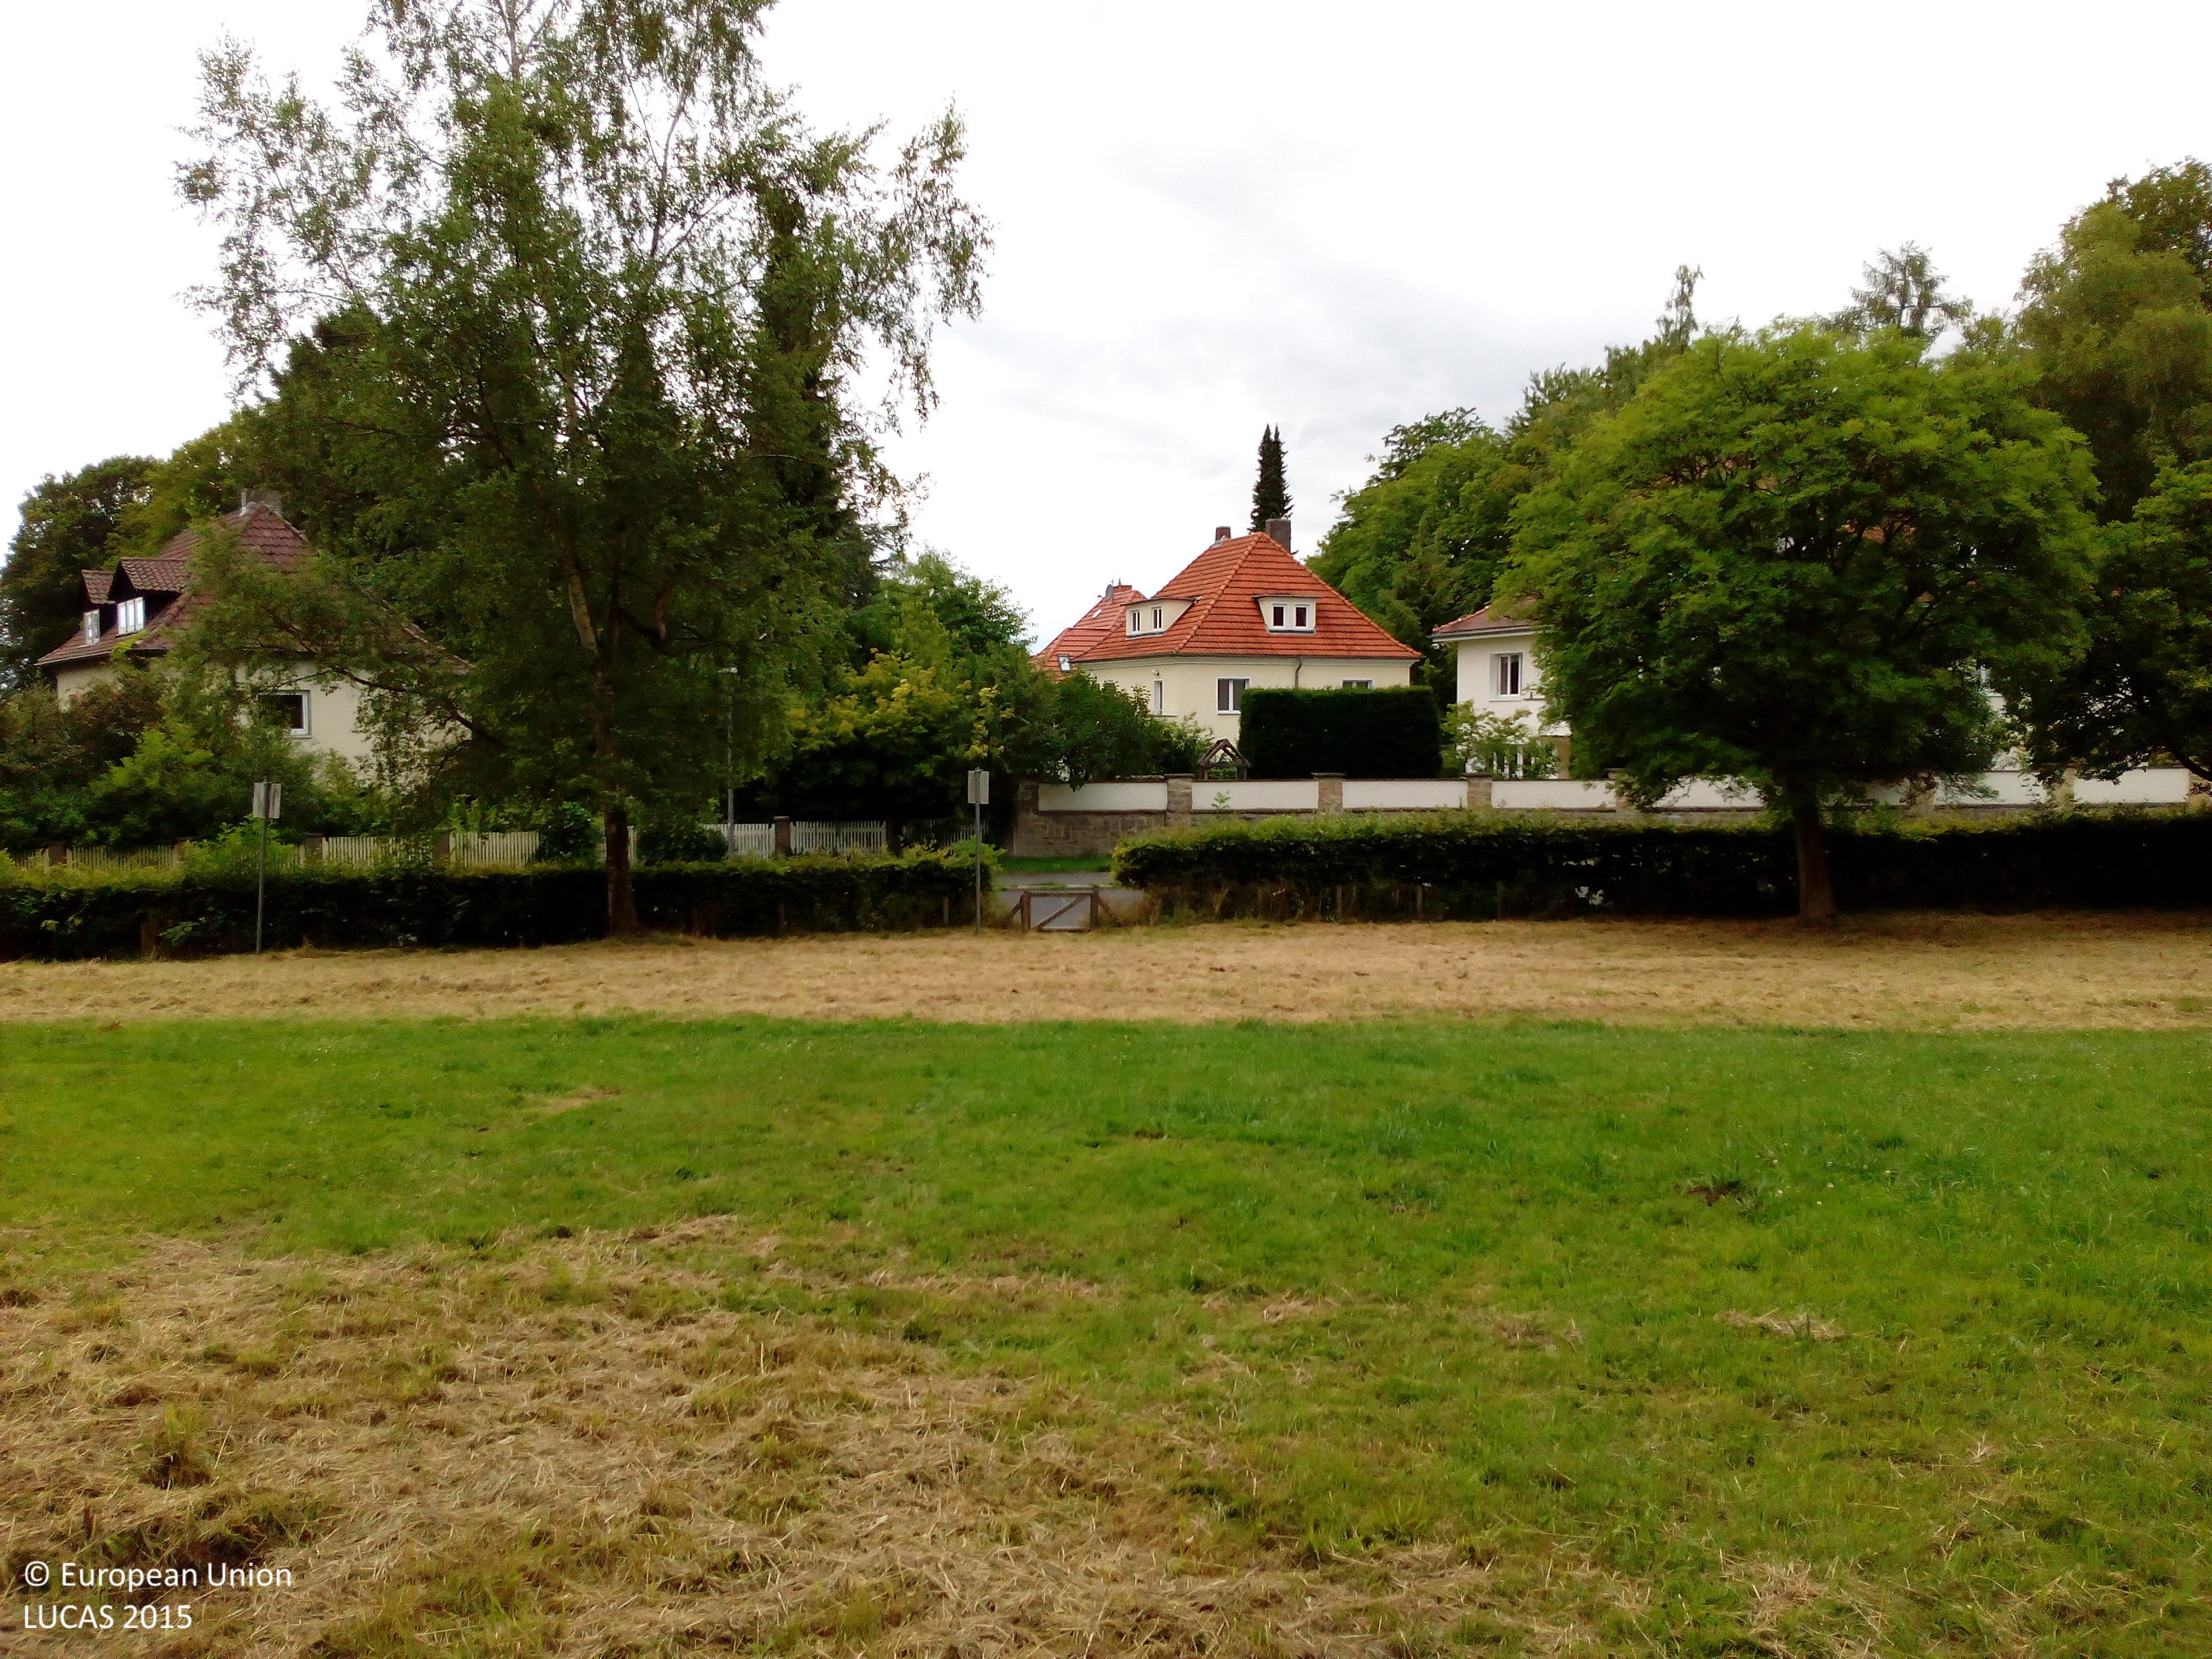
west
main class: Grassland
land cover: Grassland without tree/shrub cover
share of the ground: > 75 %
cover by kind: herbaceous plants 100 %
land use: Community services
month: July
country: DE
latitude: 51.5326
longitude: 9.9568
